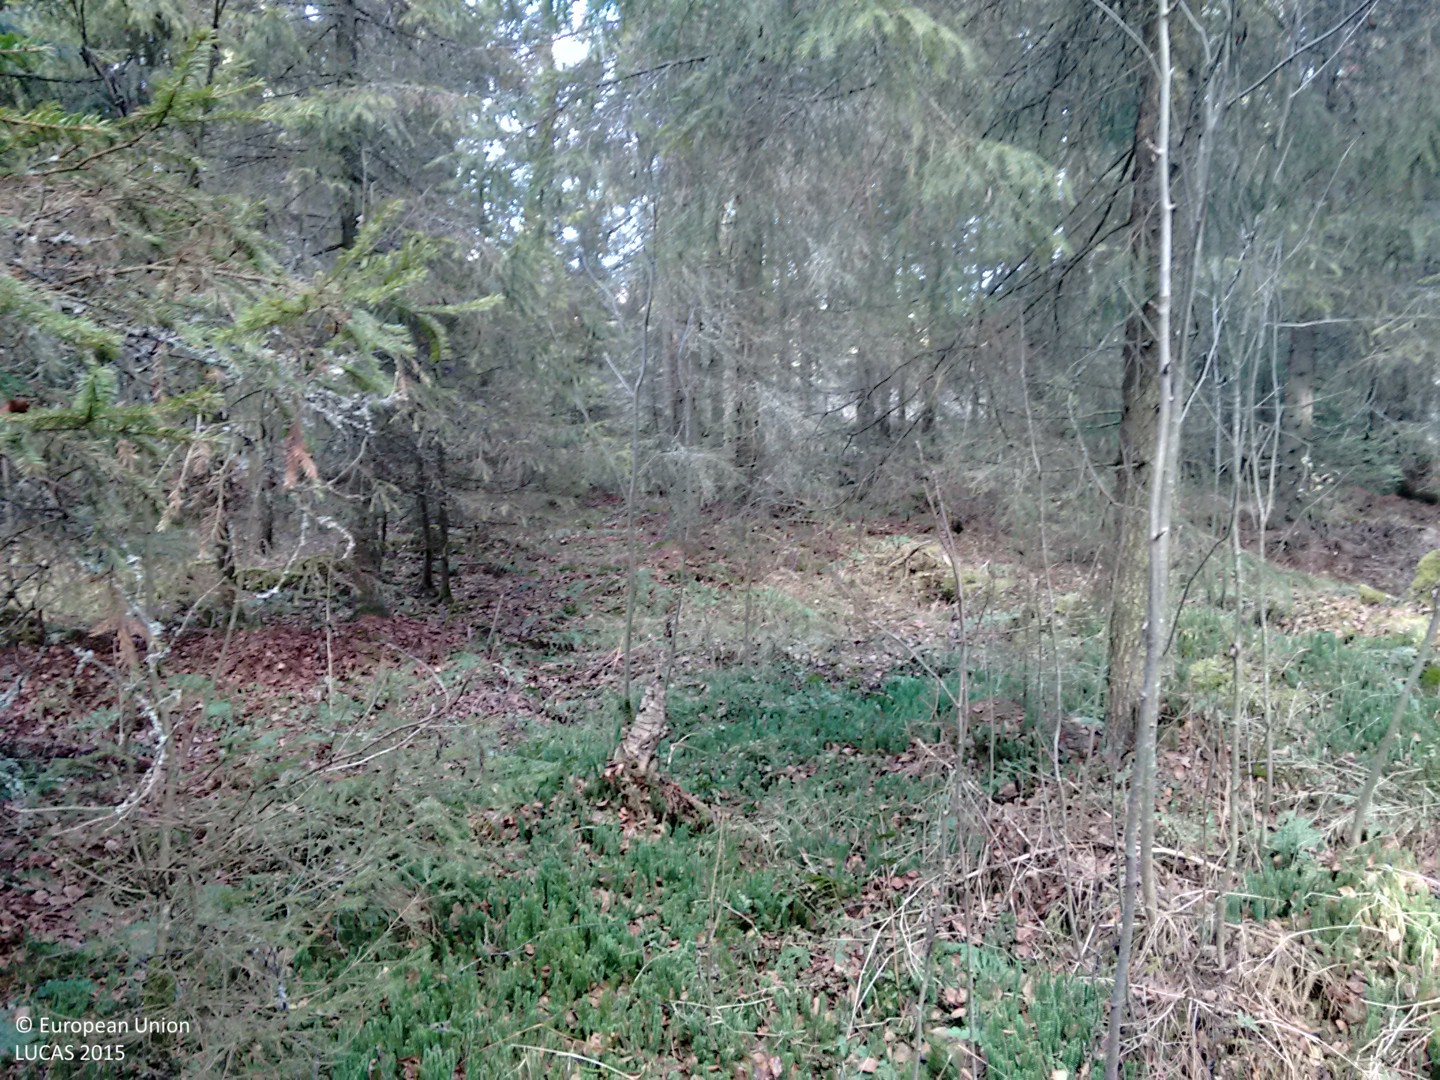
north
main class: Woodland
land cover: Spruce dominated mixed woodland
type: boreal forest
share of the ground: > 75 %
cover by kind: coniferous forest trees 60 %, broadleaved forest trees 25 %, herbaceous plants 10 %, shrubs 5 %
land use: Forestry
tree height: > 5 m
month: October
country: FI
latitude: 63.9186
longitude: 25.1964
